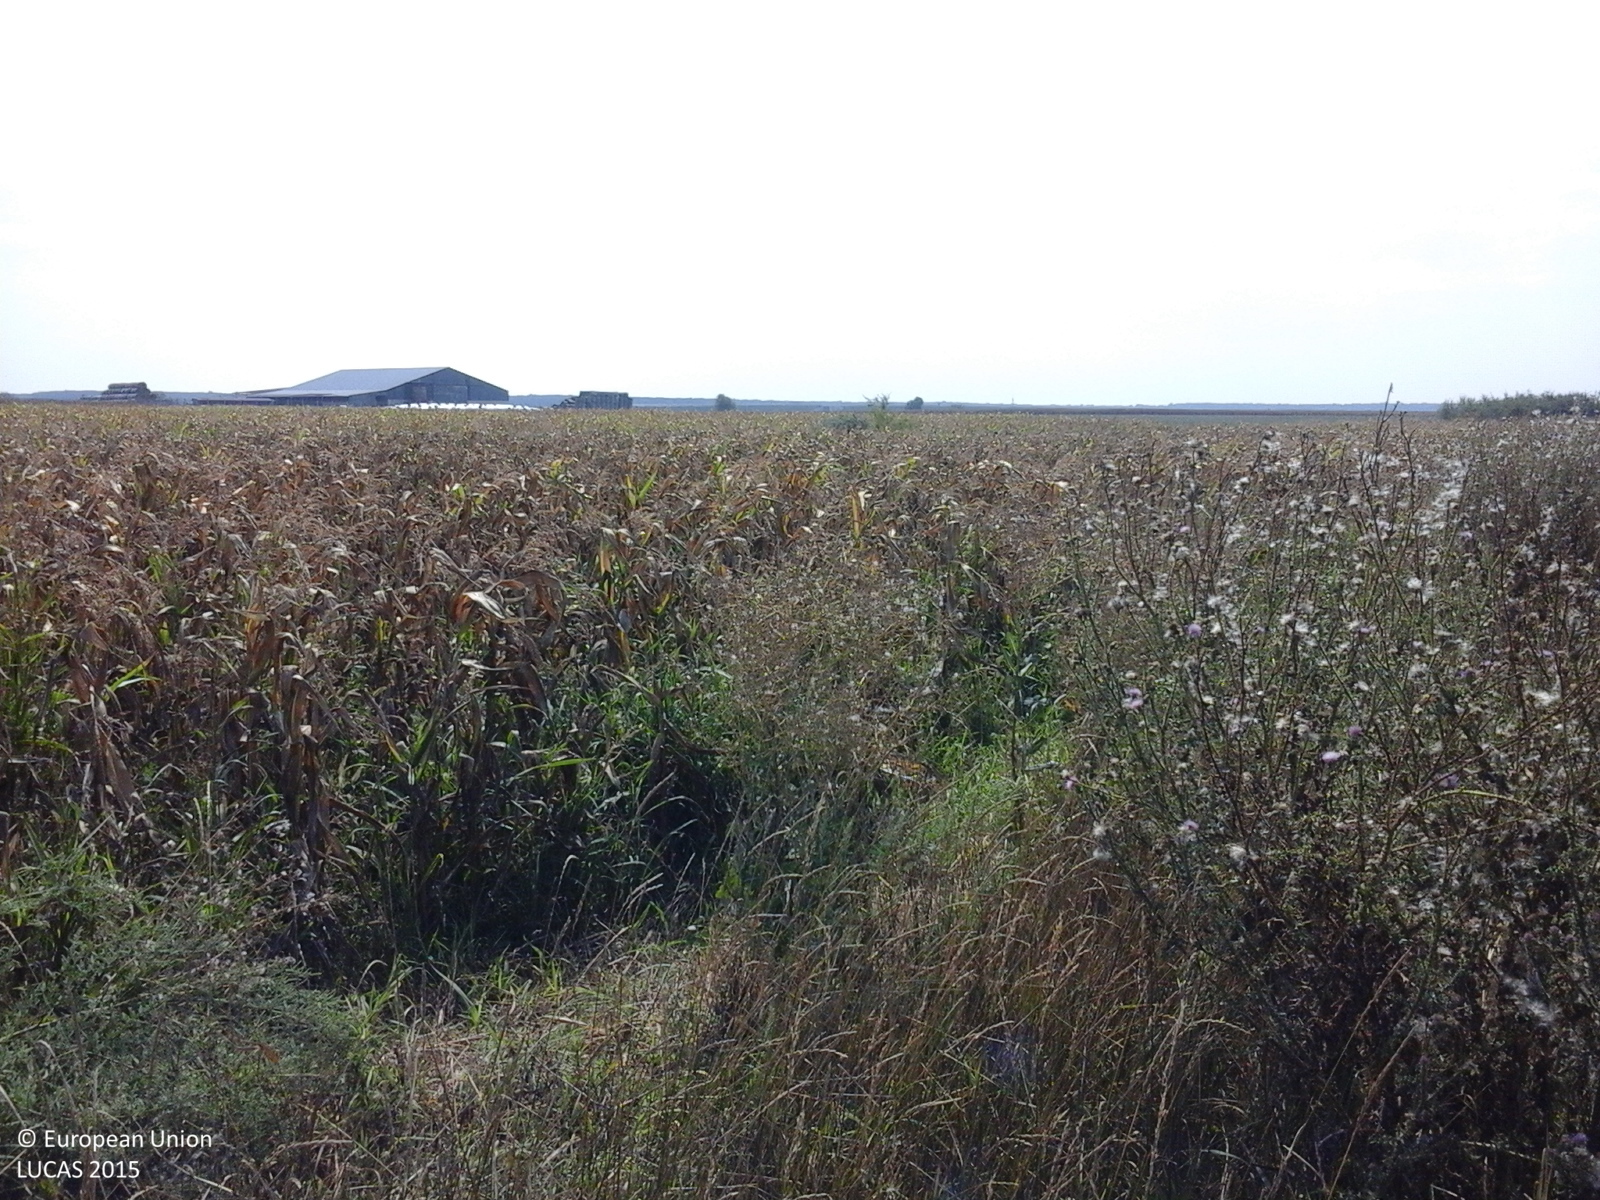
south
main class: Cropland
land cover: Maize
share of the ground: > 75 %
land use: Agriculture (excluding fallow land and kitchen gardens)
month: August
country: RO
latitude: 46.1859
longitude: 21.1350
